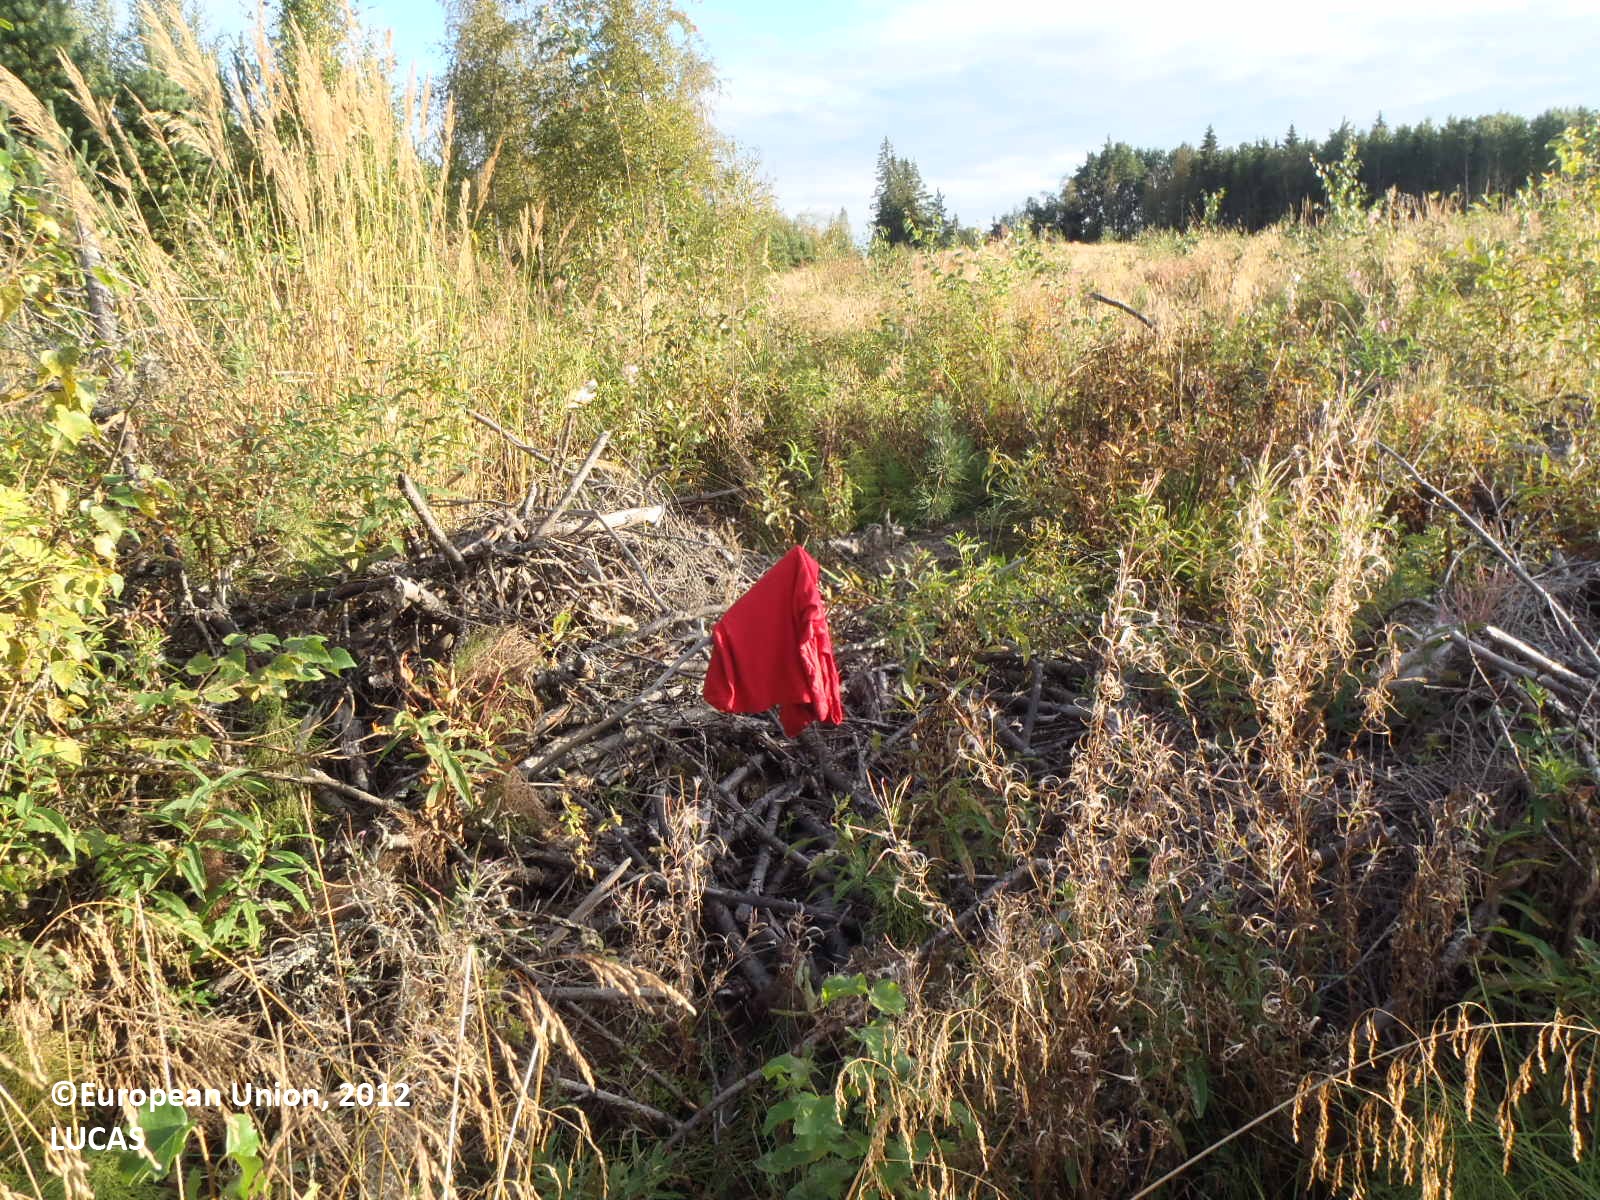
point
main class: Woodland
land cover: Broadleaved woodland
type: boreal forest
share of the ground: 10 - 25 %
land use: Forestry
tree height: < 5 m
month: August
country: FI
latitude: 60.6137
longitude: 22.4370
